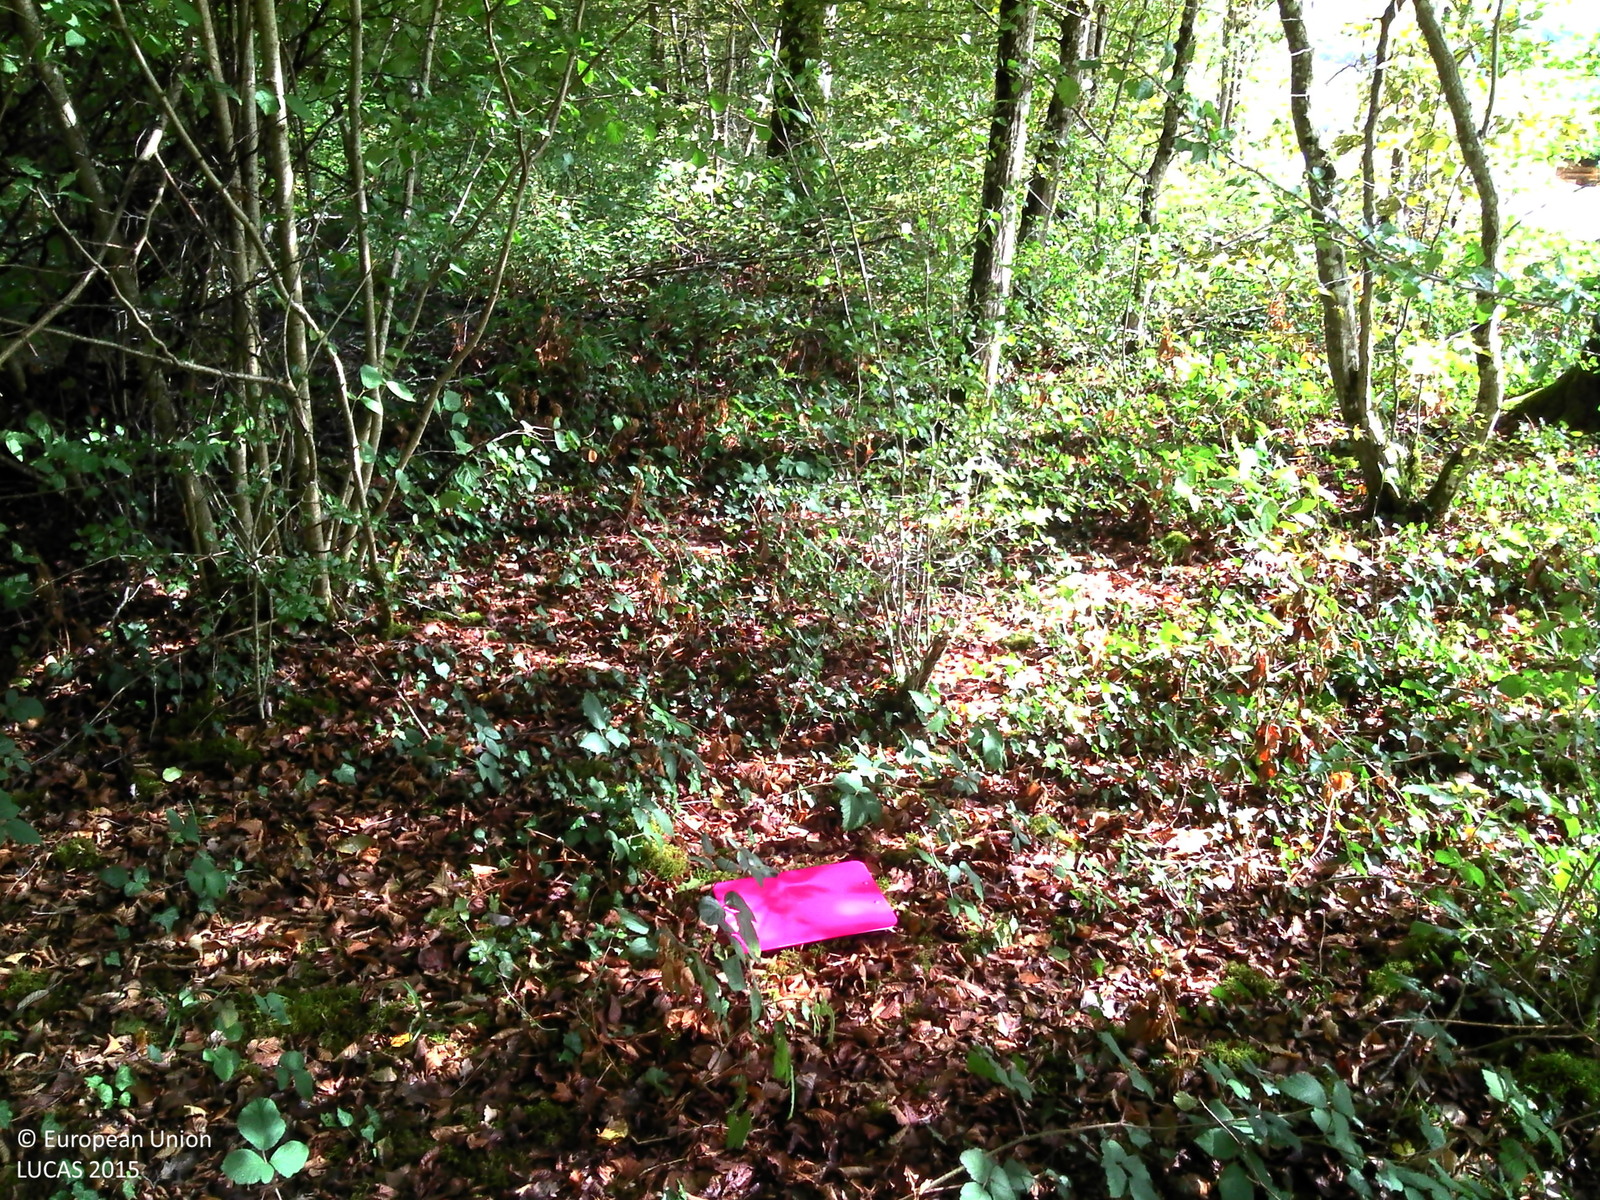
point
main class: Woodland
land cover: Broadleaved woodland
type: mesophytic deciduous forest
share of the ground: > 75 %
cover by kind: broadleaved forest trees 90 %, herbaceous plants 10 %
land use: Forestry
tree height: > 5 m
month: September
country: FR
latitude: 48.0587
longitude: 4.6715
